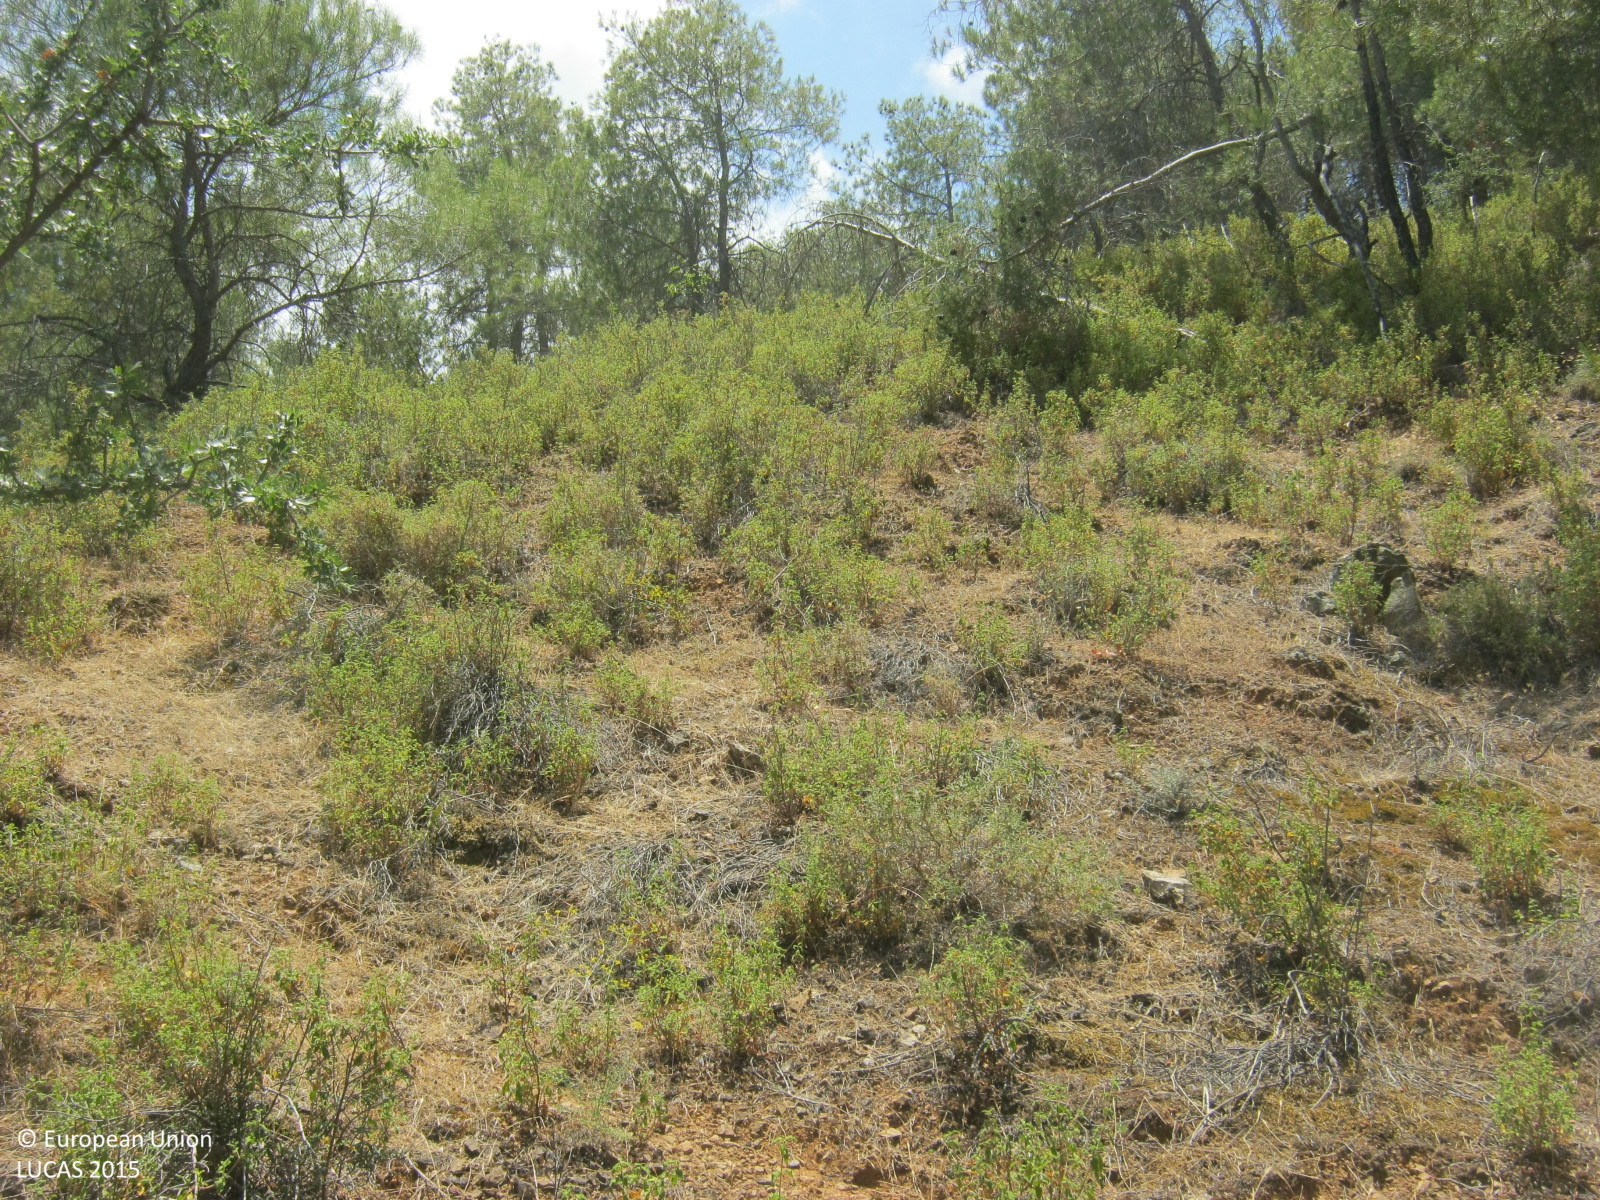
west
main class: Woodland
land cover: Pine dominated coniferous woodland
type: coniferous forest of the mediterranean region
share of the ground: 50 - 75 %
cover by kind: coniferous forest trees 60 %, shrubs 20 %, broadleaved forest trees 10 %, unconsolidated bare surface 10 %
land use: Forestry
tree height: > 5 m
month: June
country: CY
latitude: 34.9925
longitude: 33.1767
